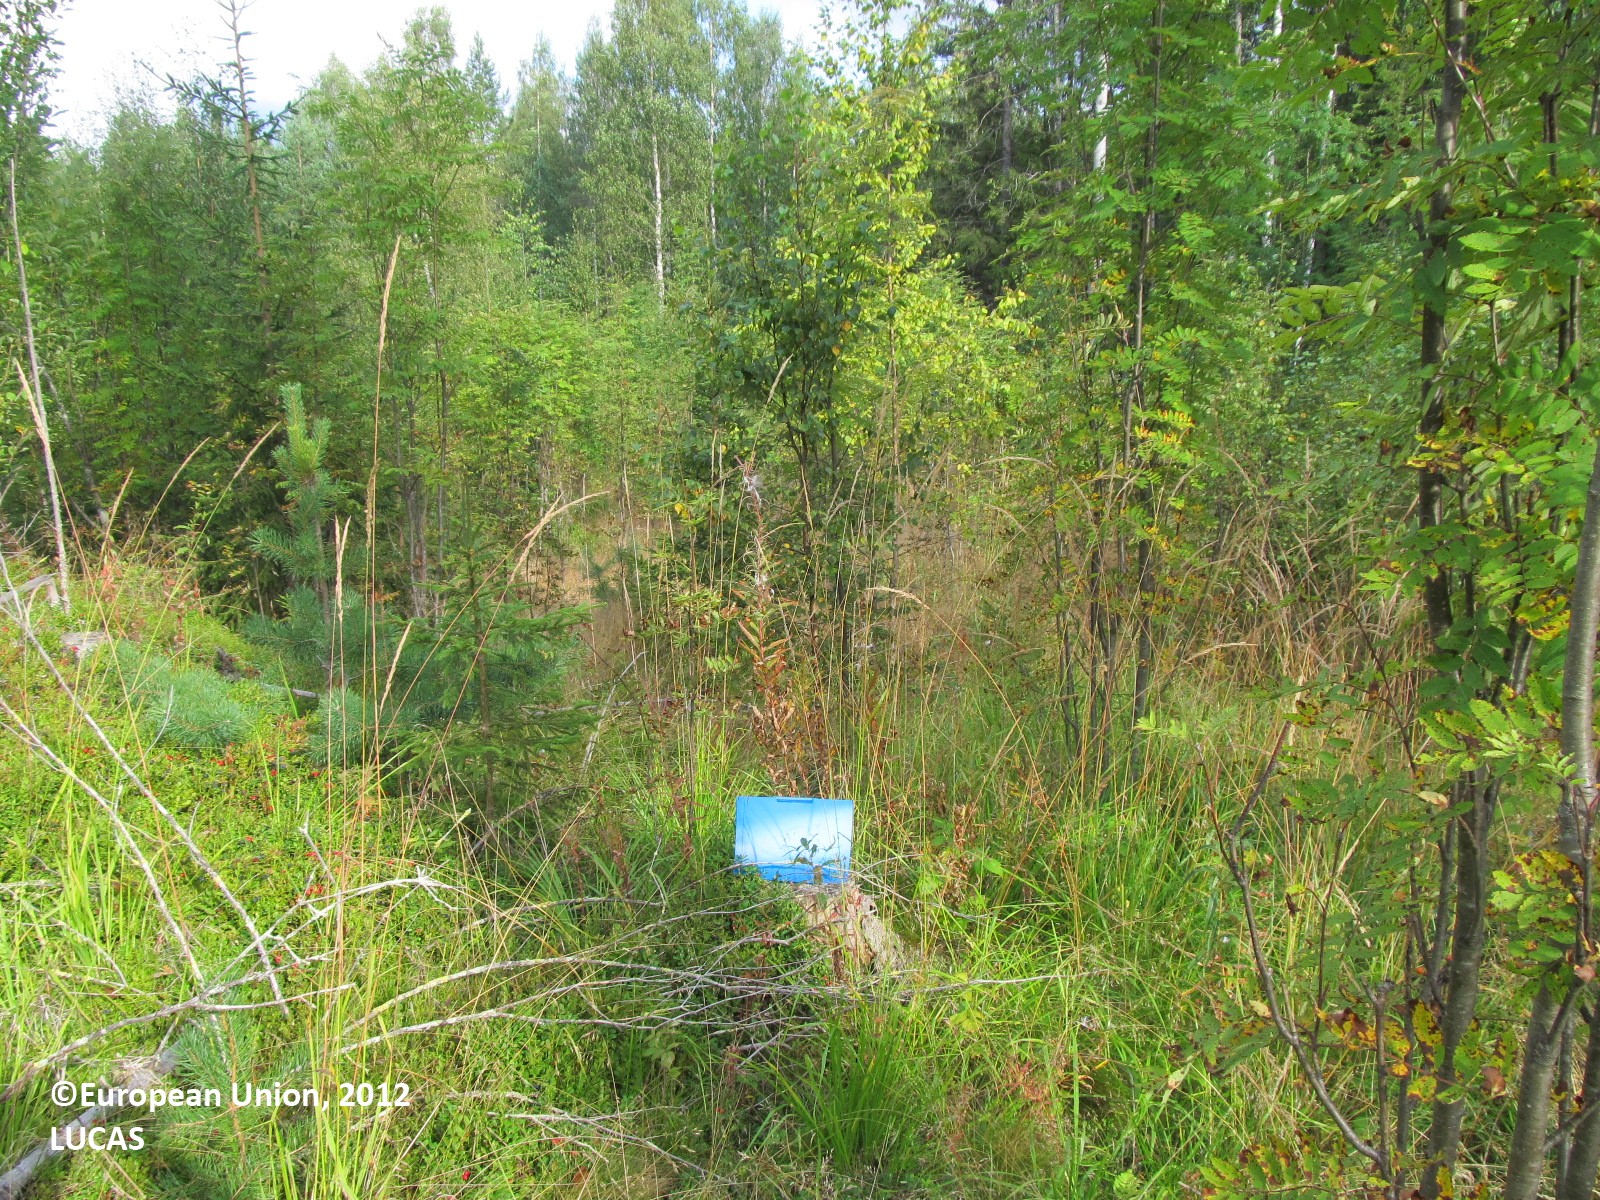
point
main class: Woodland
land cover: Pine dominated mixed woodland
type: boreal forest
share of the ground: 25 - 50 %
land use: Forestry
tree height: > 5 m
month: August
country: FI
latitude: 61.9193
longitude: 27.5621
